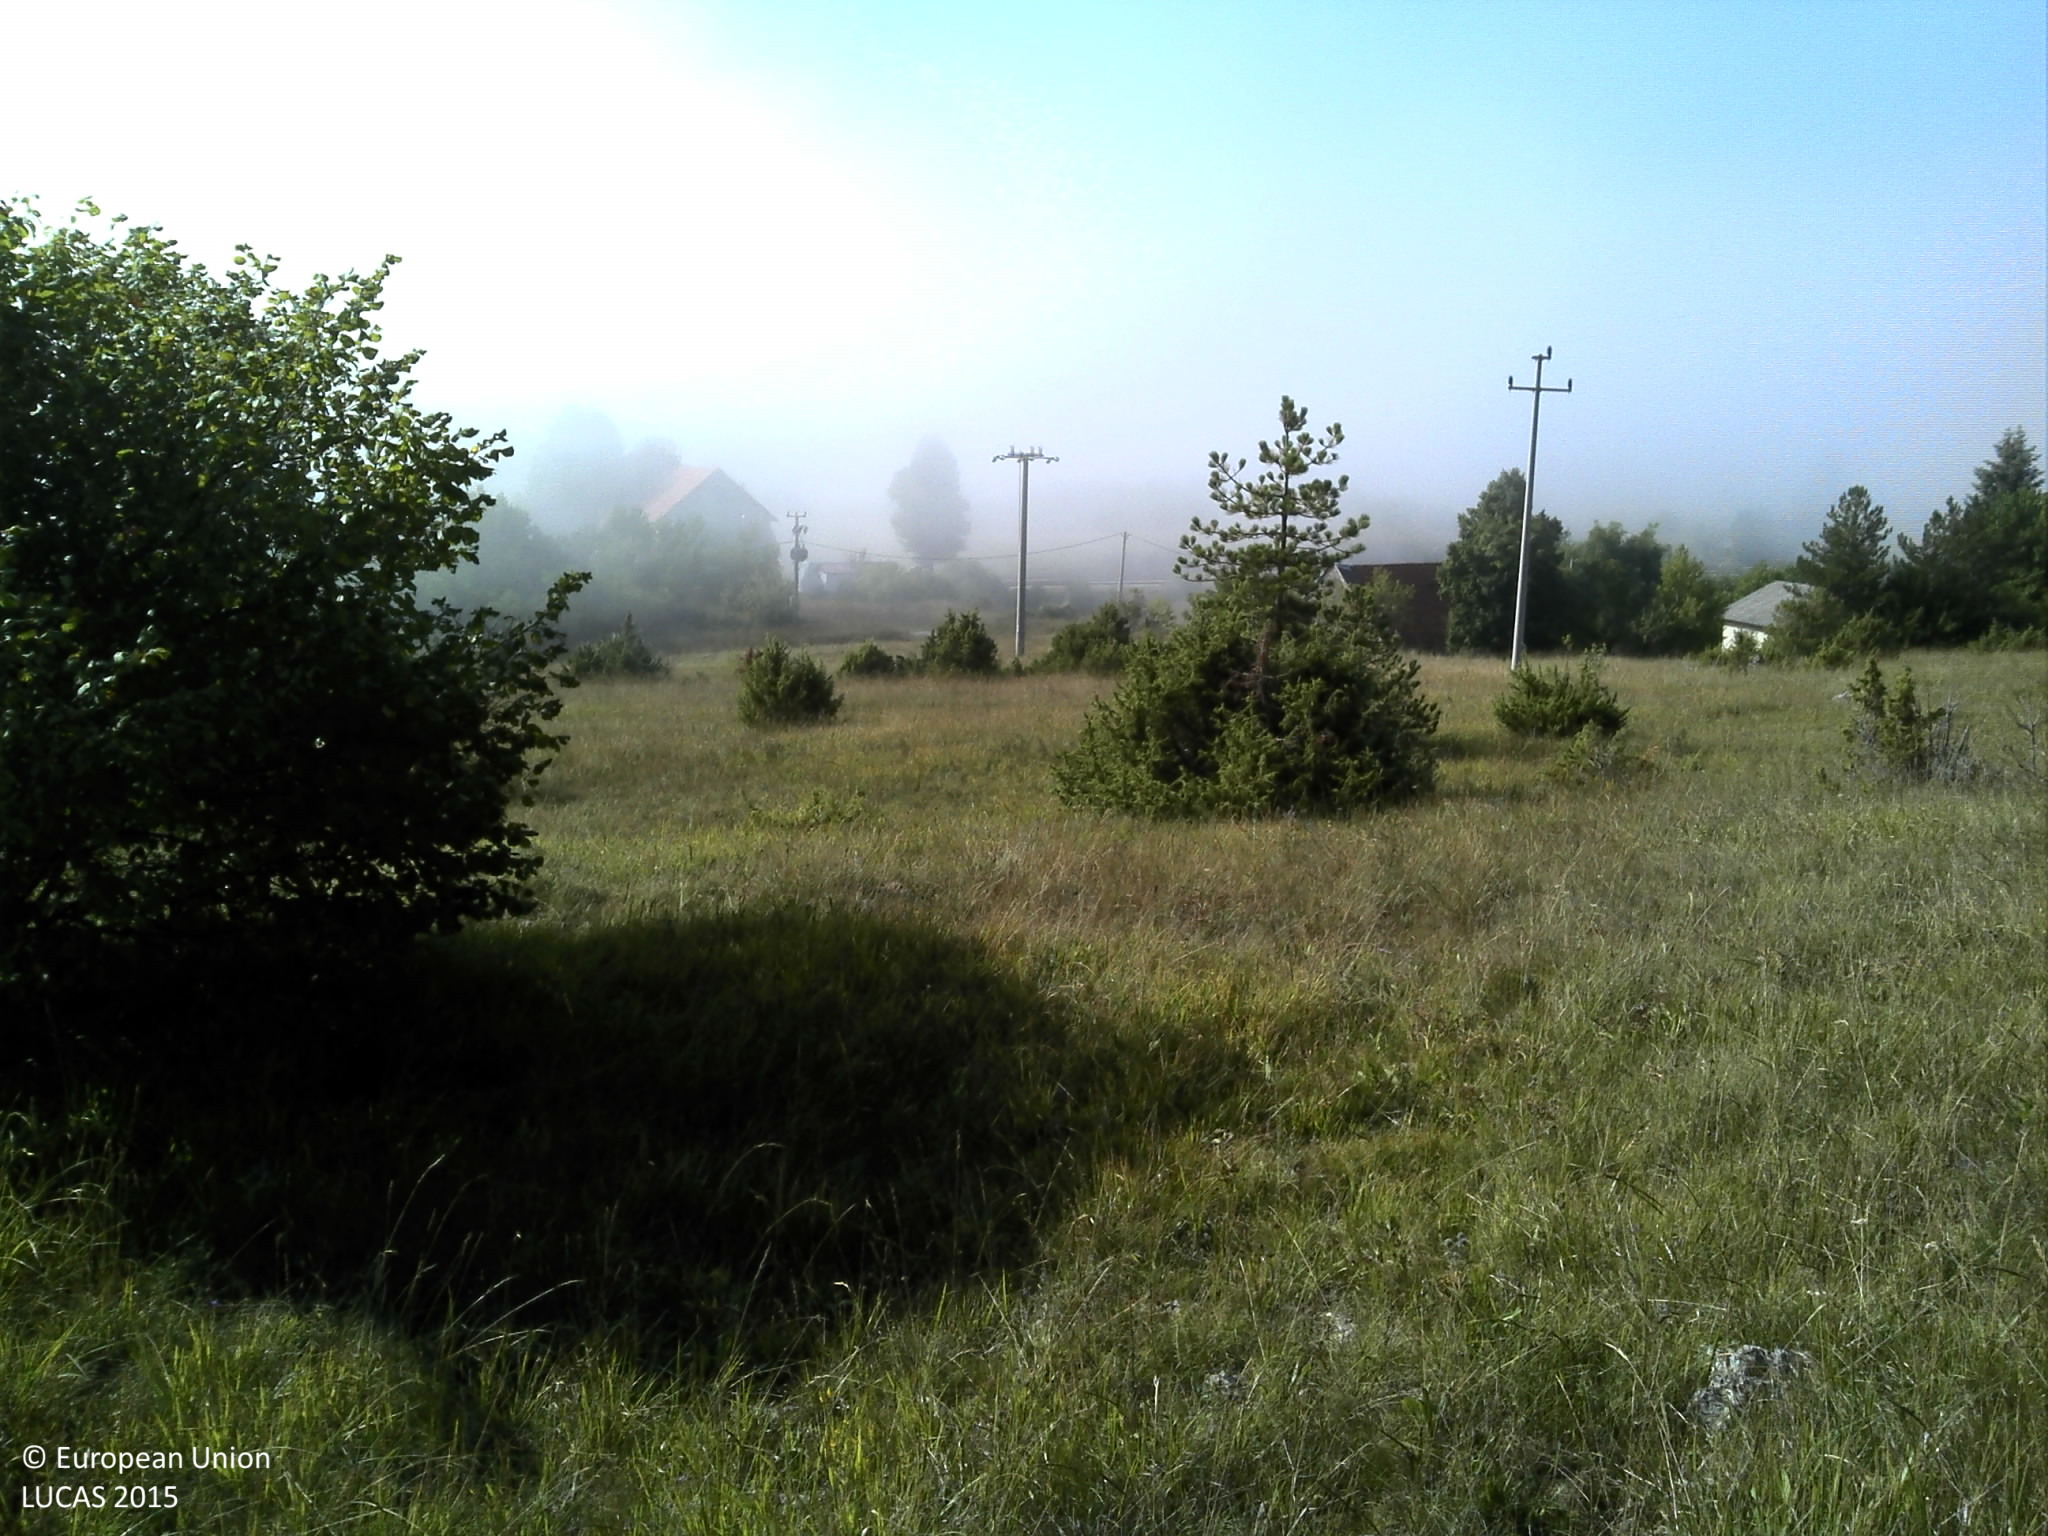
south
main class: Grassland
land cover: Grassland with sparse tree/shrub cover
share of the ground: > 75 %
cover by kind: herbaceous plants 80 %, shrubs 10 %, coniferous forest trees 5 %, unconsolidated bare surface 5 %
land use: Abandoned areas
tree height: < 5 m
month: August
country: HR
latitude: 44.2691
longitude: 15.9687
